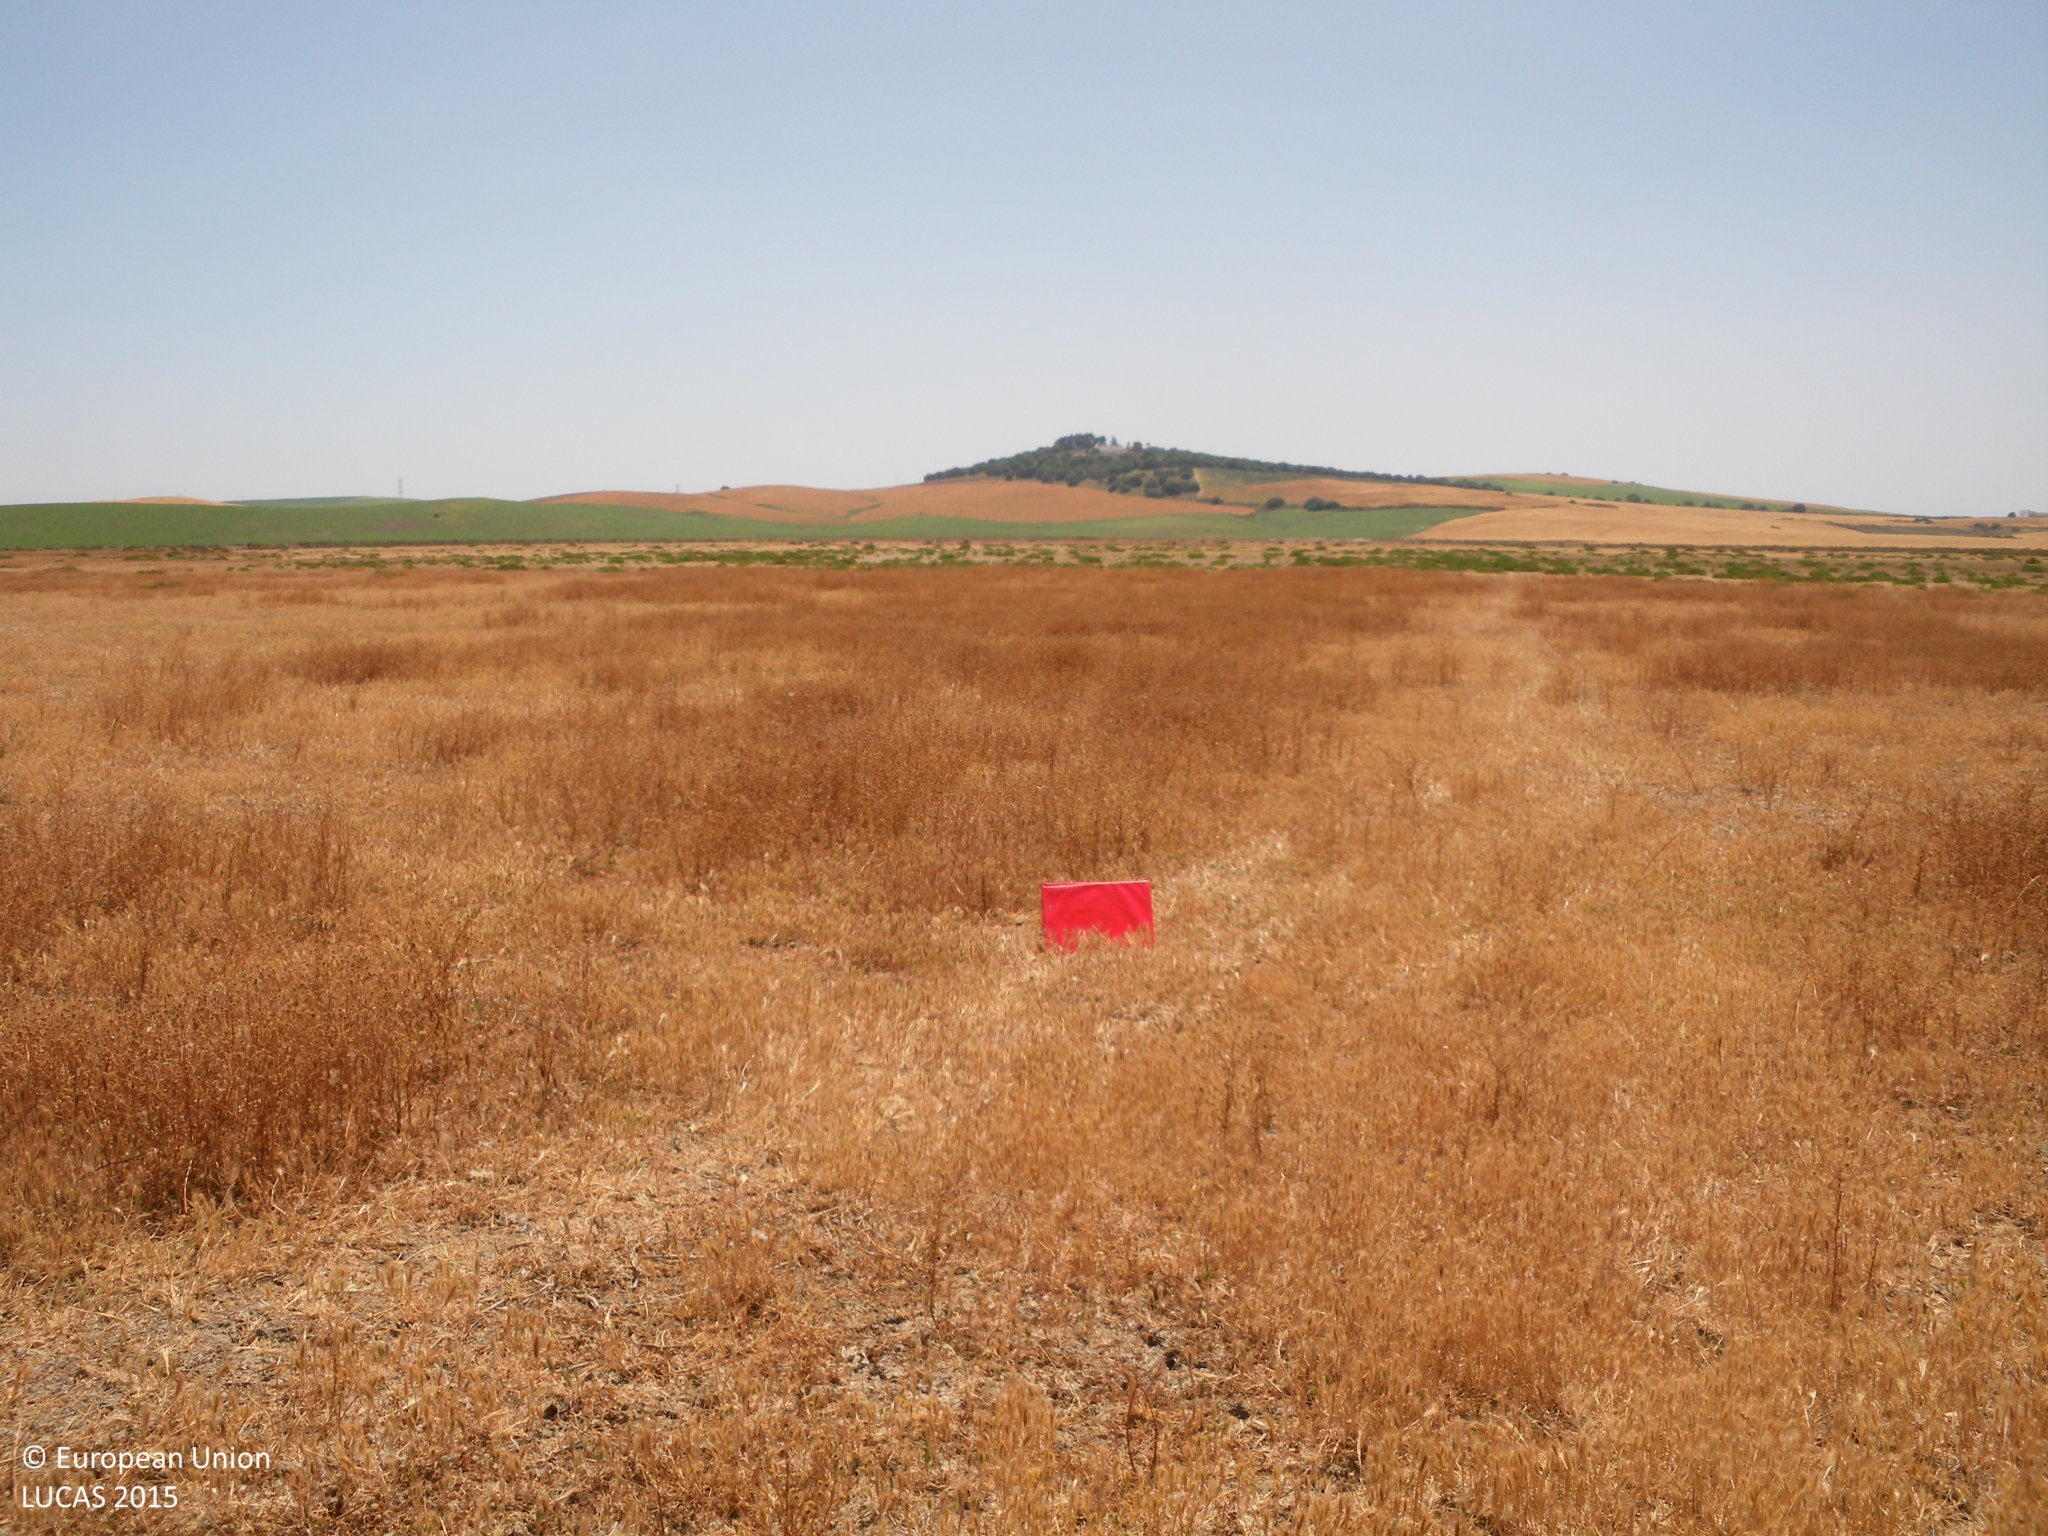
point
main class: Grassland
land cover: Spontaneously vegetated surfaces
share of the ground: > 75 %
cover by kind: herbaceous plants 90 %, unconsolidated bare surface 10 %
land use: Agriculture (excluding fallow land and kitchen gardens)
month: May
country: ES
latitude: 36.8430
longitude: -6.2210
